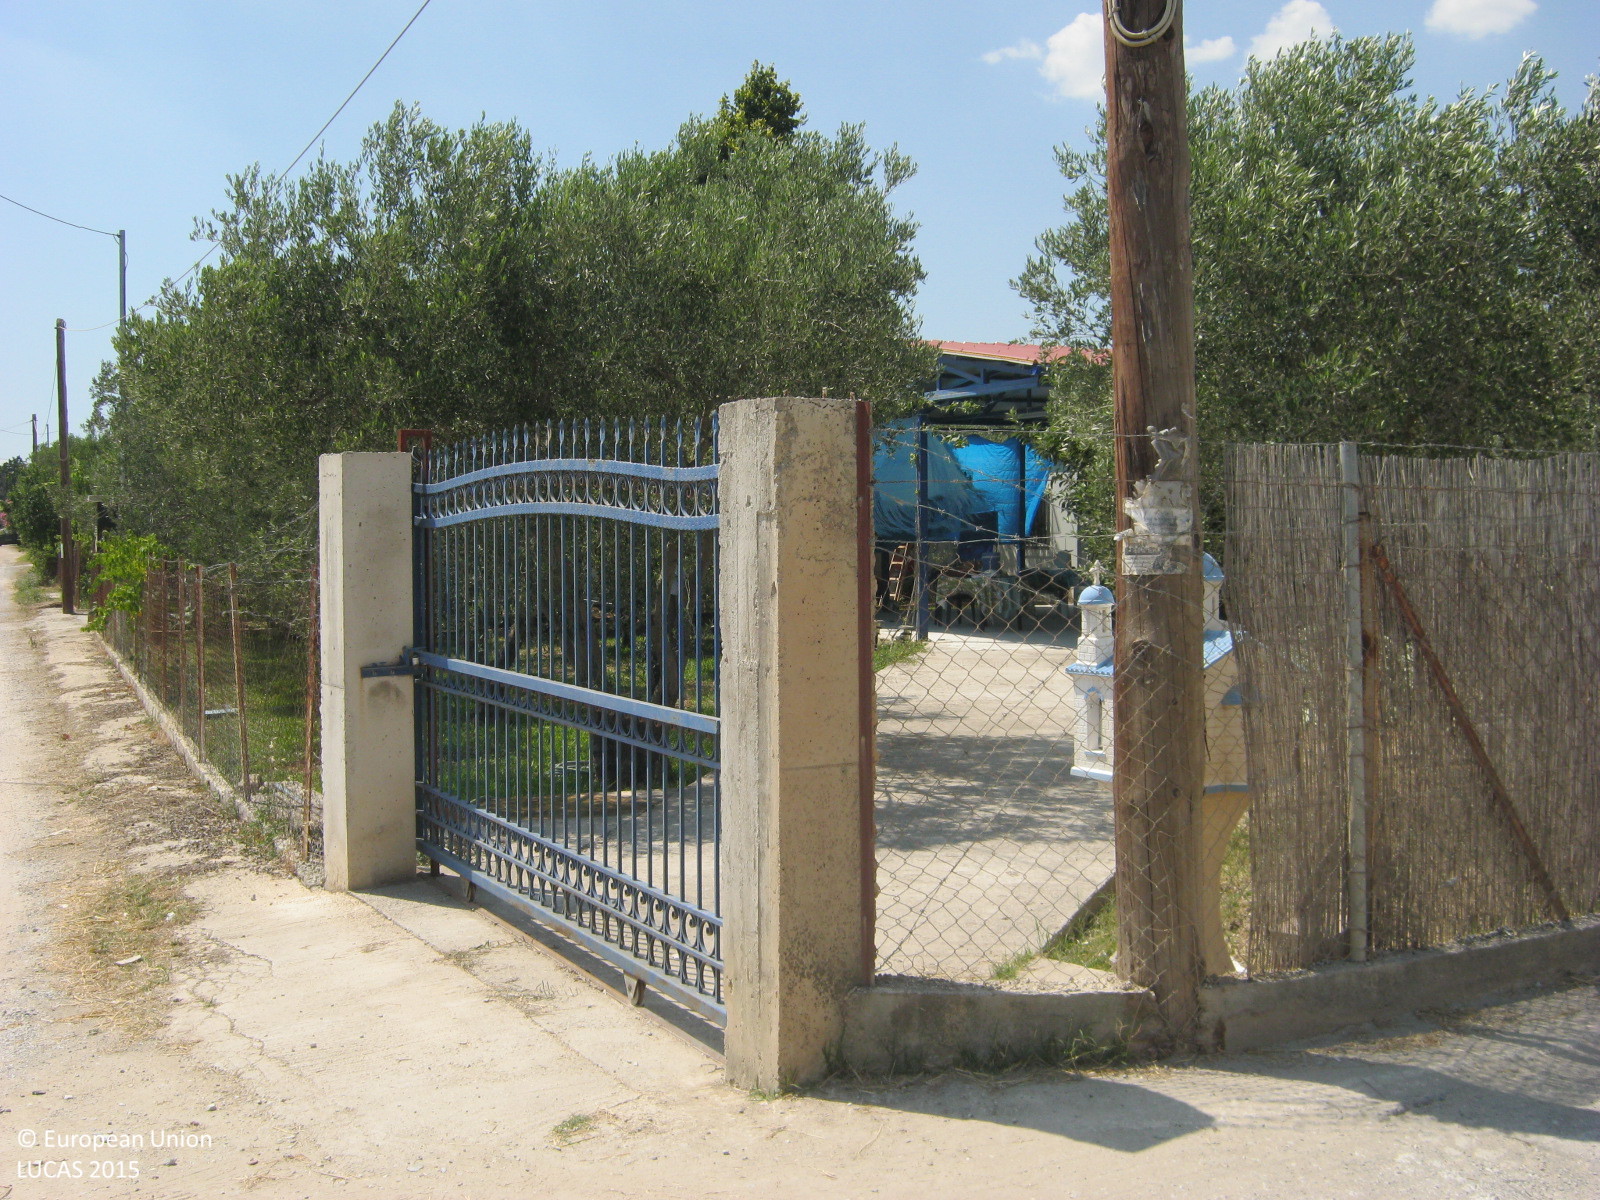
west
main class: Grassland
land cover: Grassland with sparse tree/shrub cover
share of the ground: > 75 %
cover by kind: herbaceous plants 95 %, broadleaved forest trees 5 %
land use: Residential
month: July
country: GR
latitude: 40.2968
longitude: 23.1225
